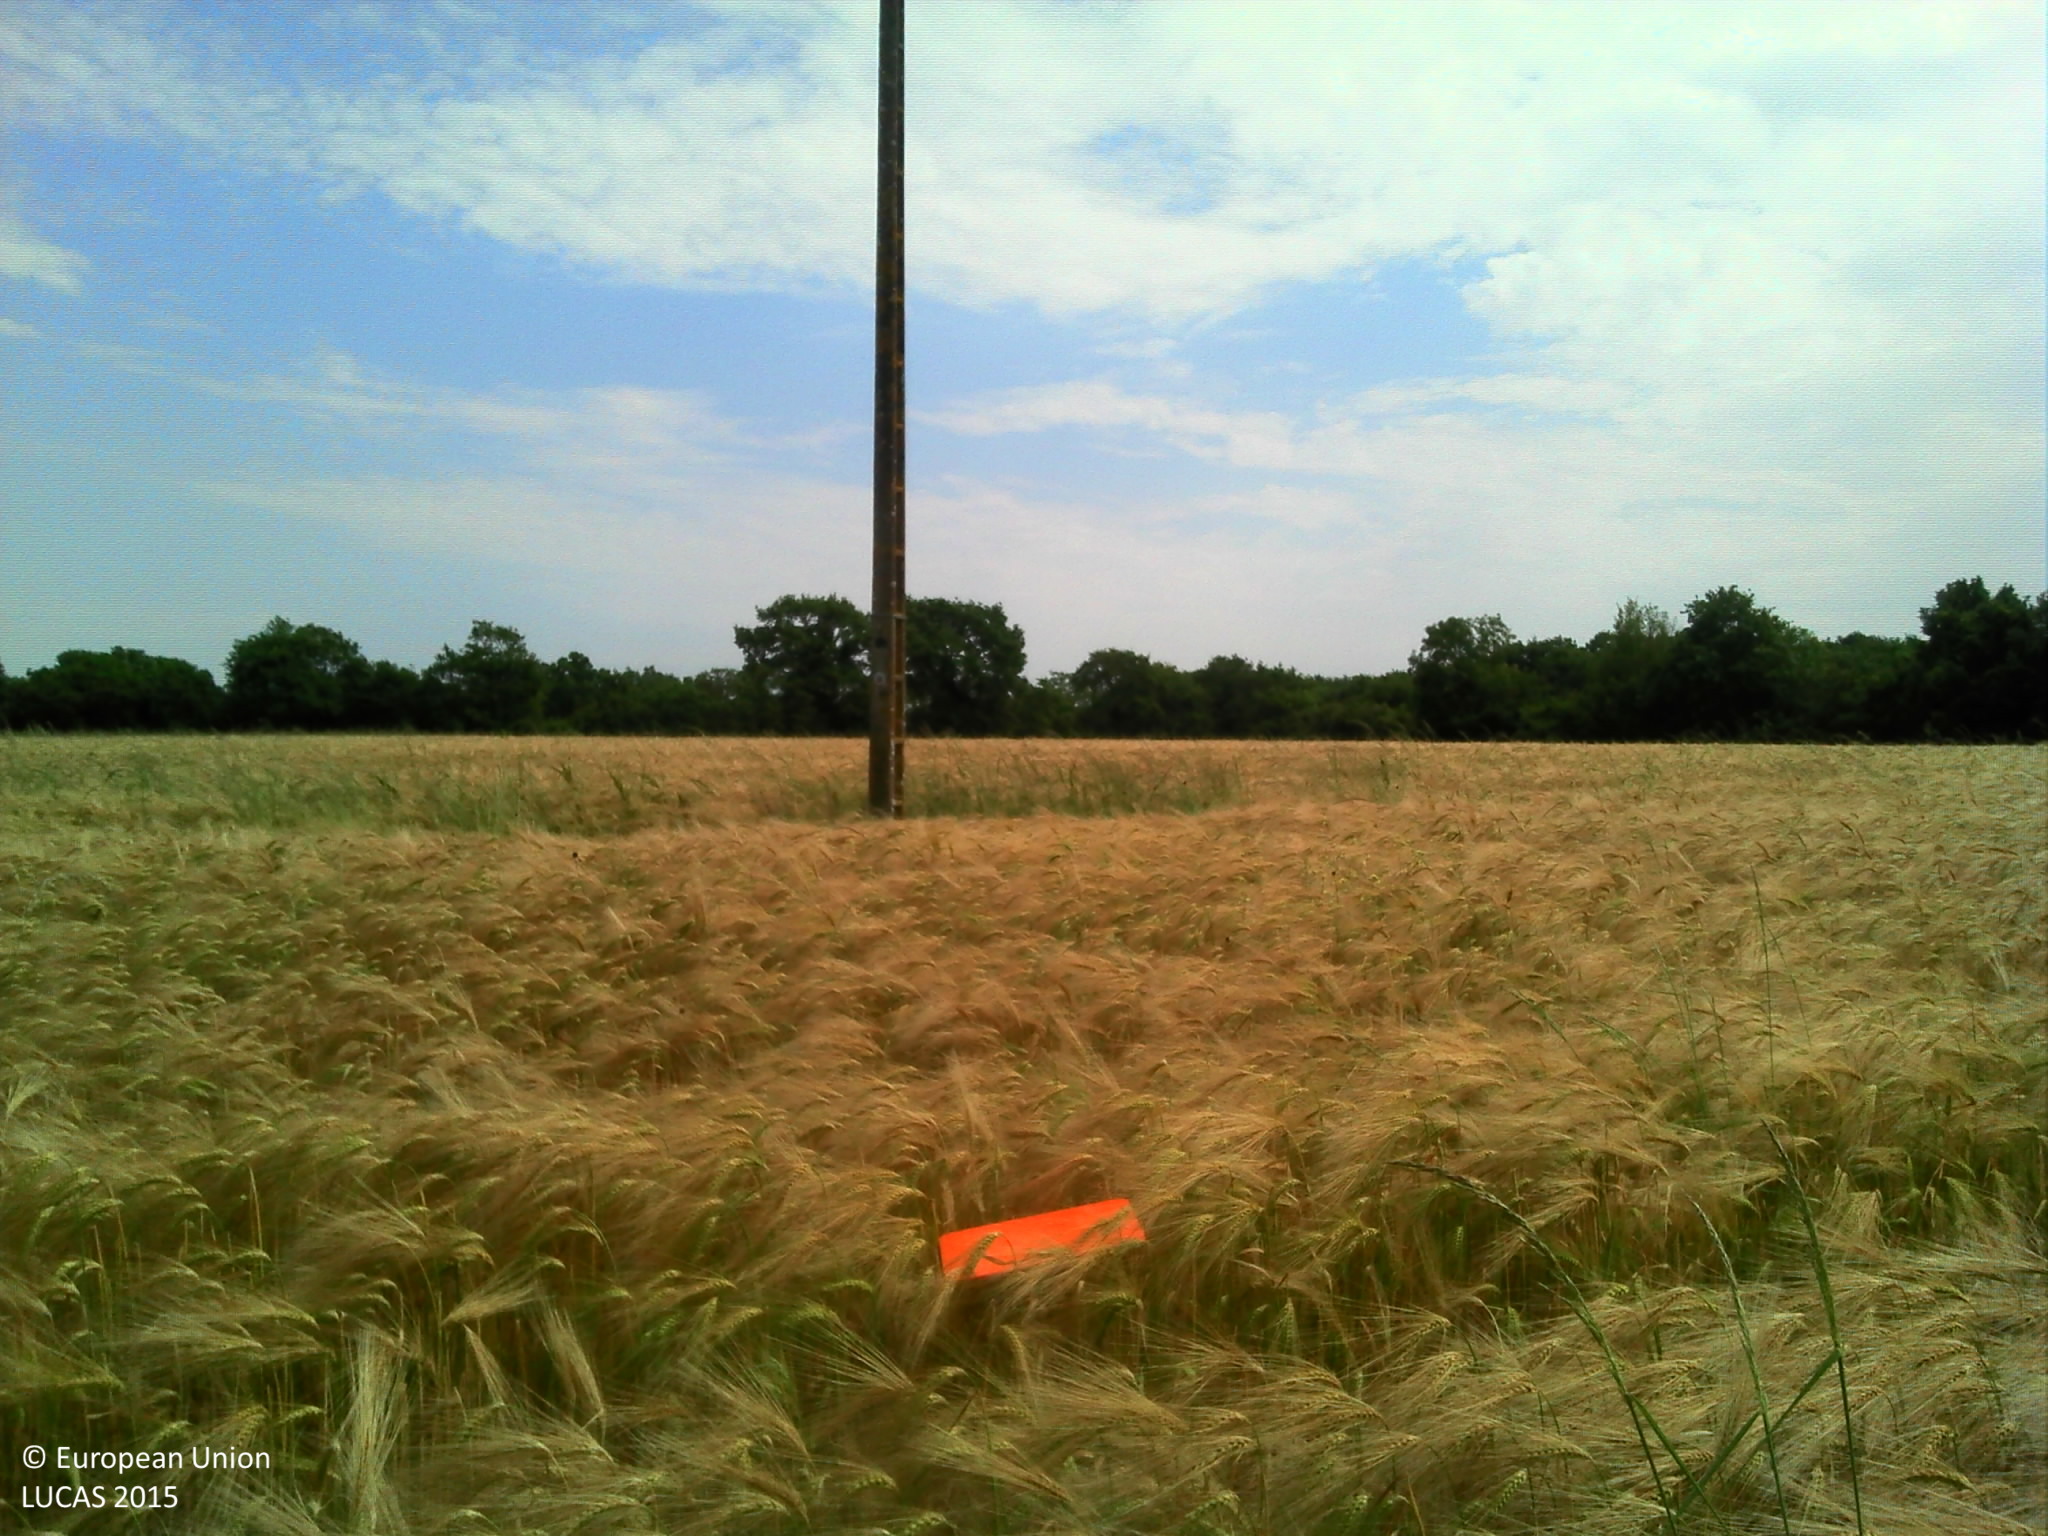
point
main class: Cropland
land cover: Barley
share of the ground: > 75 %
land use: Agriculture (excluding fallow land and kitchen gardens)
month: June
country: FR
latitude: 46.7907
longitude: -1.7674
